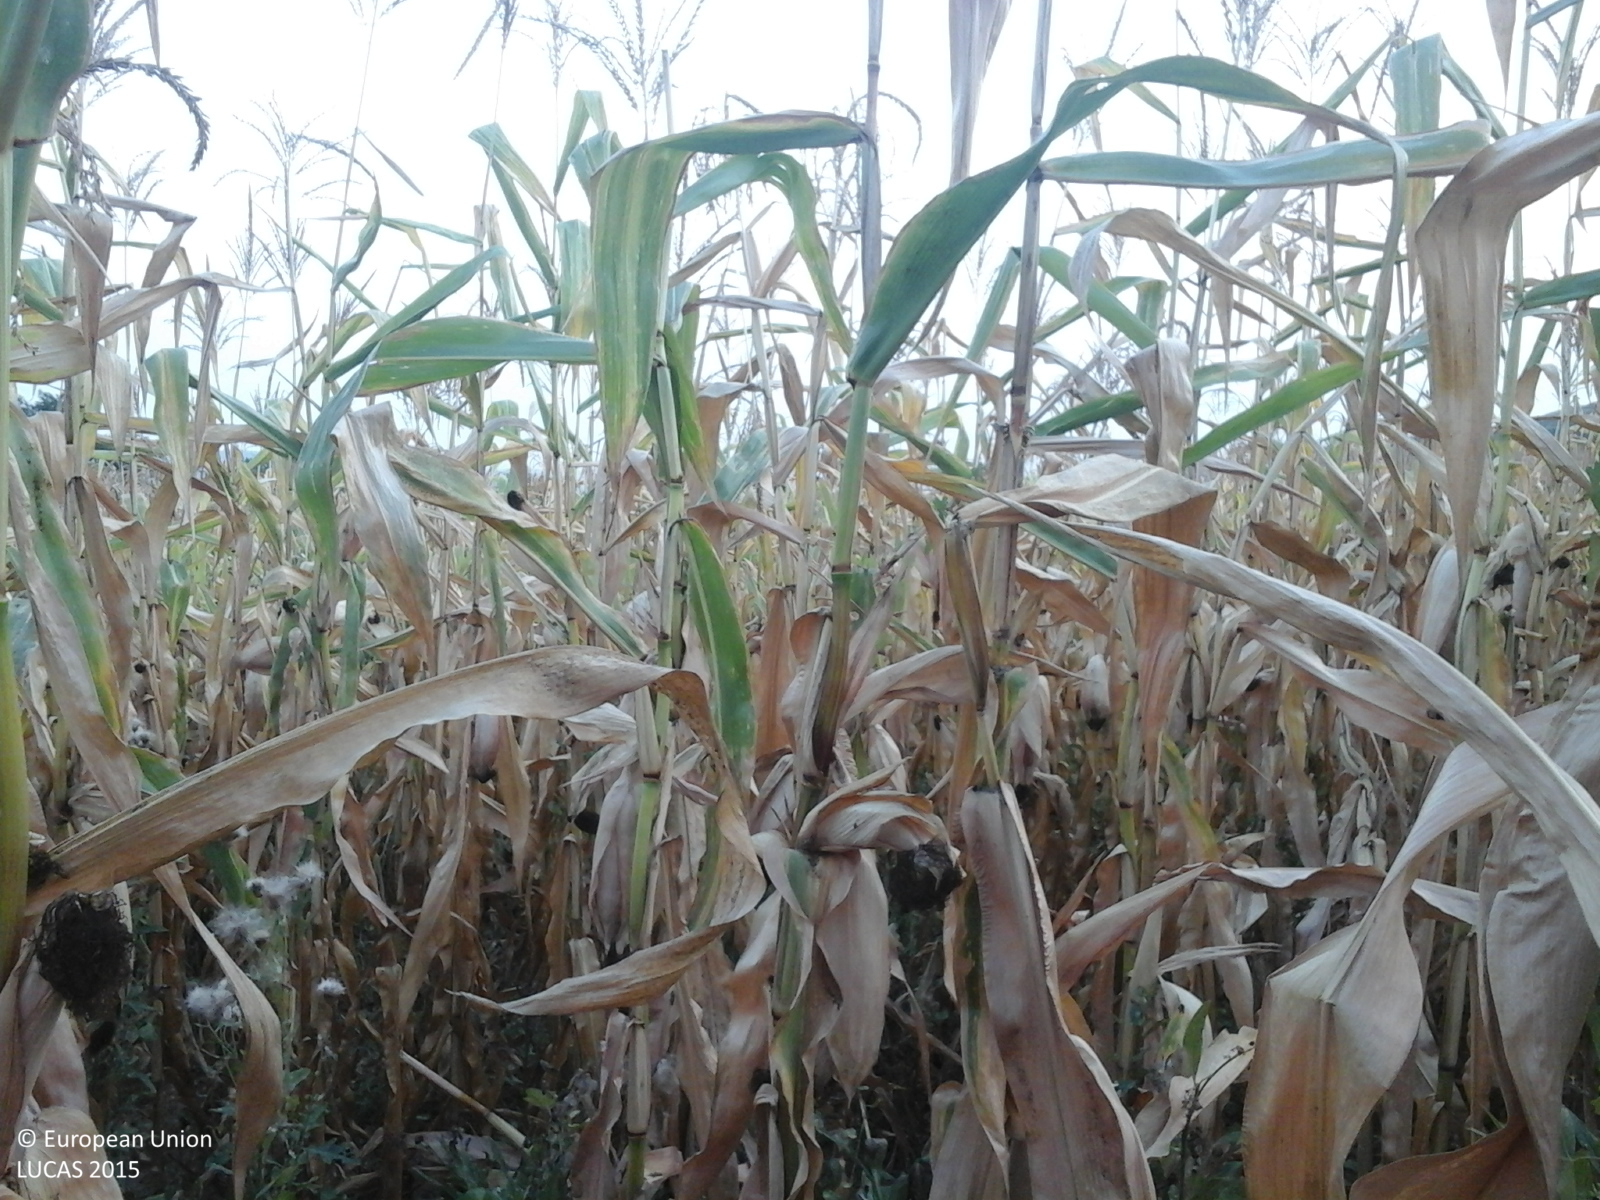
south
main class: Cropland
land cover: Maize
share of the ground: > 75 %
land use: Agriculture (excluding fallow land and kitchen gardens)
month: September
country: RO
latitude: 47.2674
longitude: 24.2961
